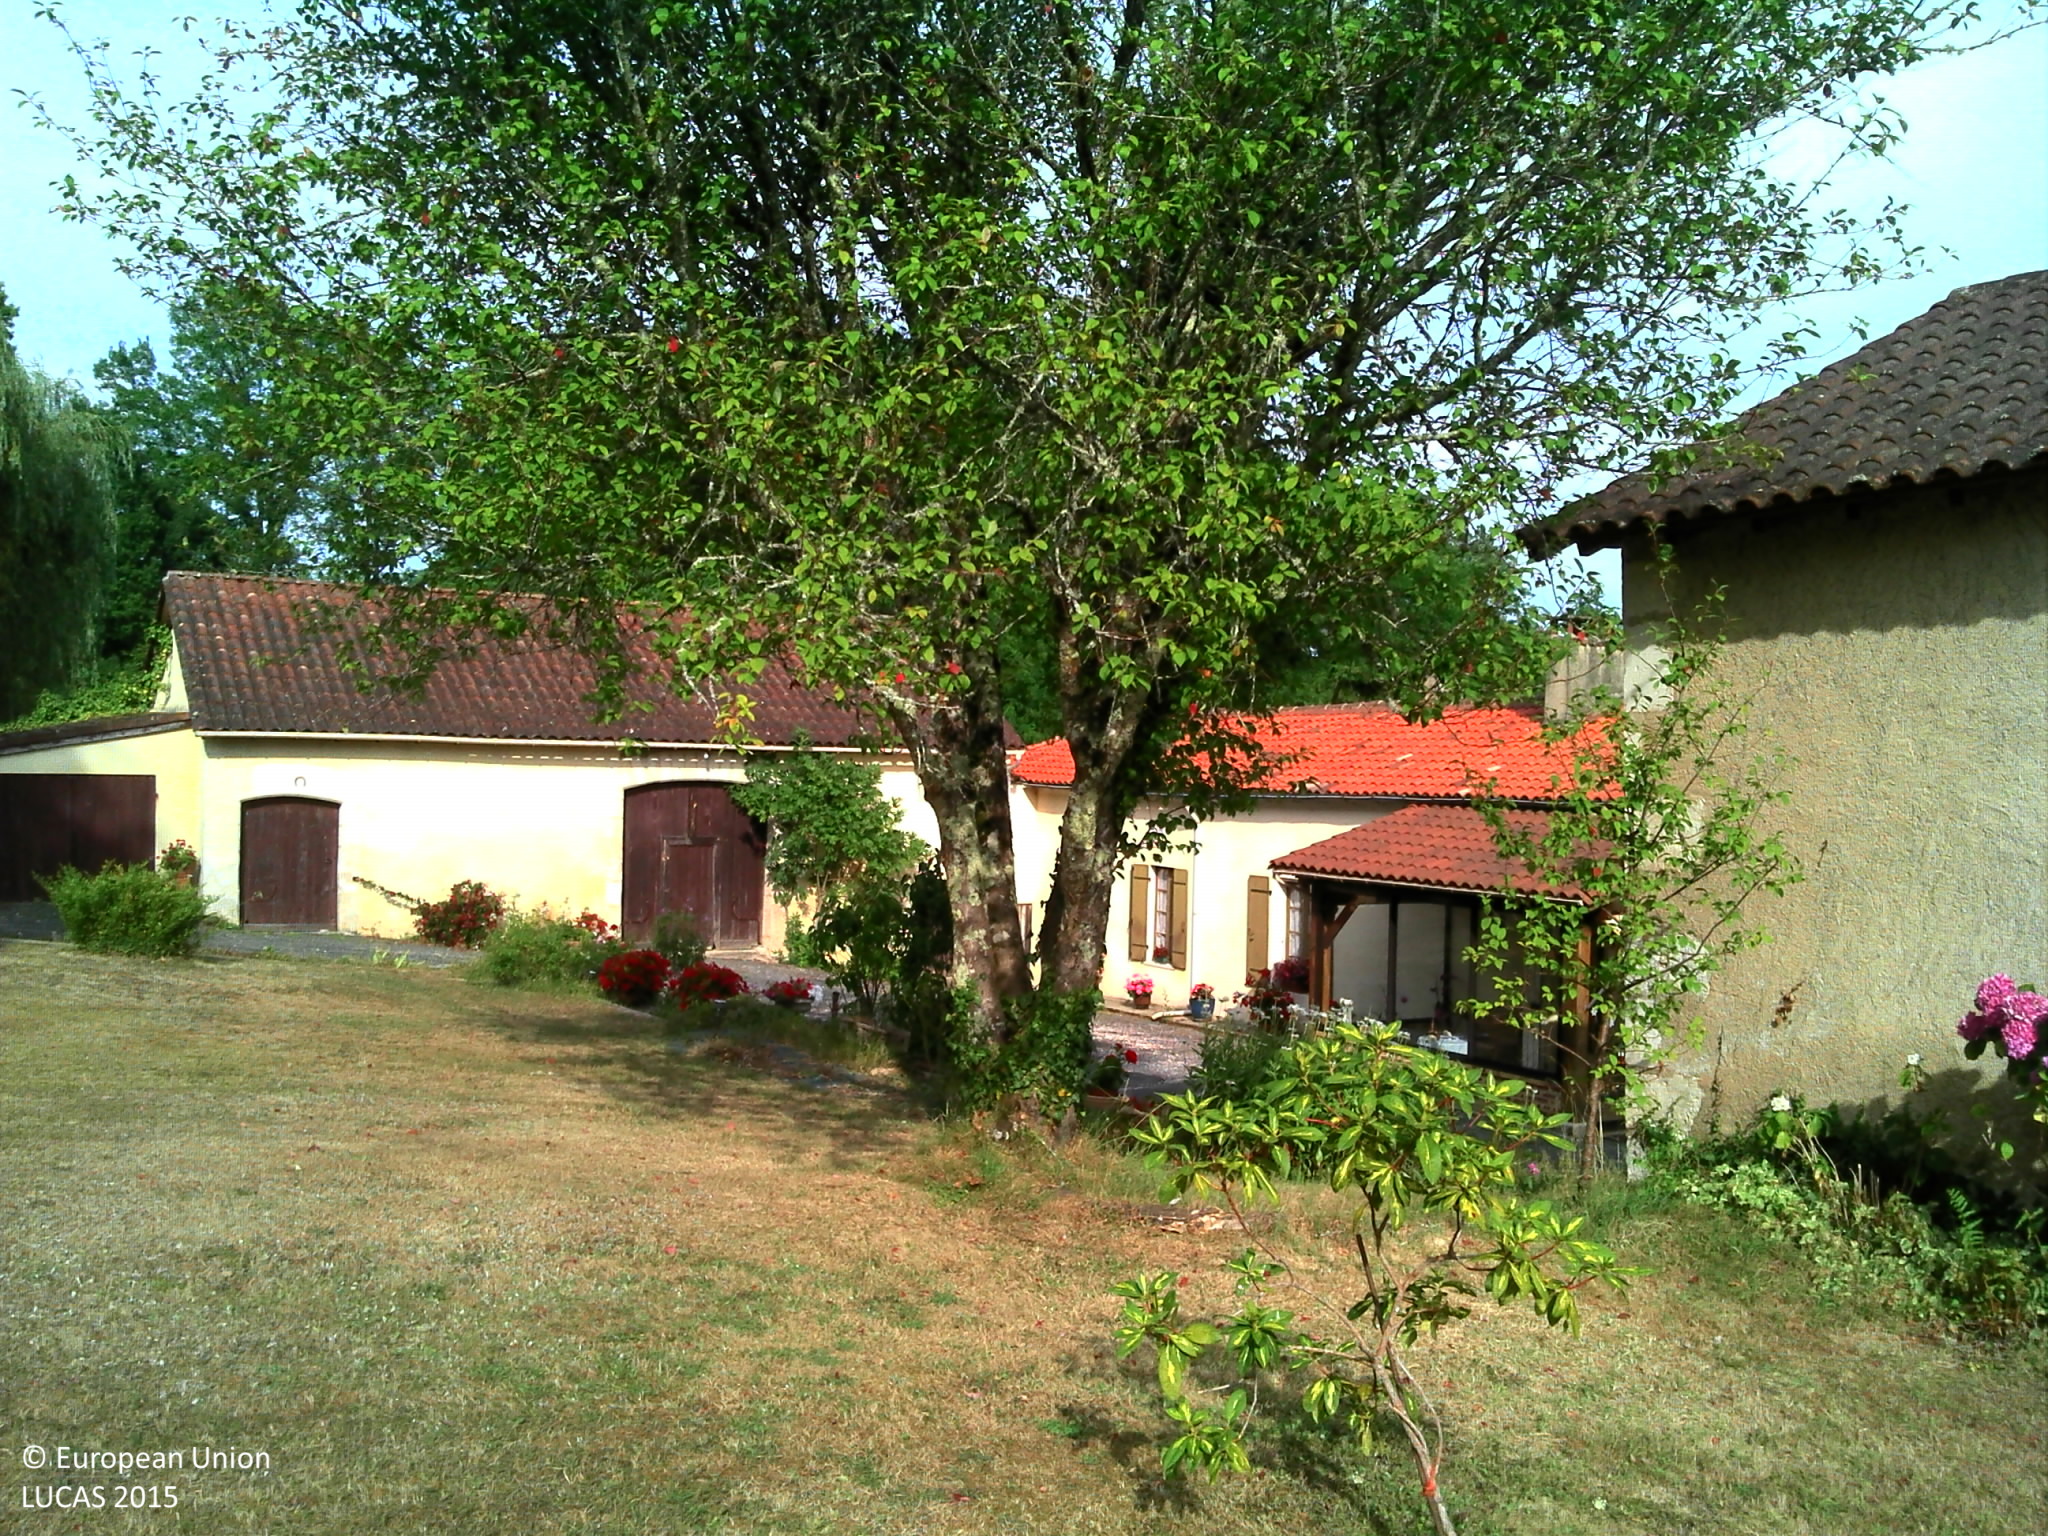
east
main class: Grassland
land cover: Grassland with sparse tree/shrub cover
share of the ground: > 75 %
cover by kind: herbaceous plants 65 %, lichens and mosses 10 %, consolidated bare surface 10 %, broadleaved forest trees 5 %
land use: Residential
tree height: > 5 m
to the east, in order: Grassland with sparse tree/shrub cover; Artificial constructions in urban areas; Broadleaved woodland; Spontaneously vegetated surfaces; Tracks; Grassland without tree/shrub cover; Broadleaved woodland; Tracks; Shrubland with sparse tree cover
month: July
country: FR
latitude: 45.0418
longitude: 0.5317
